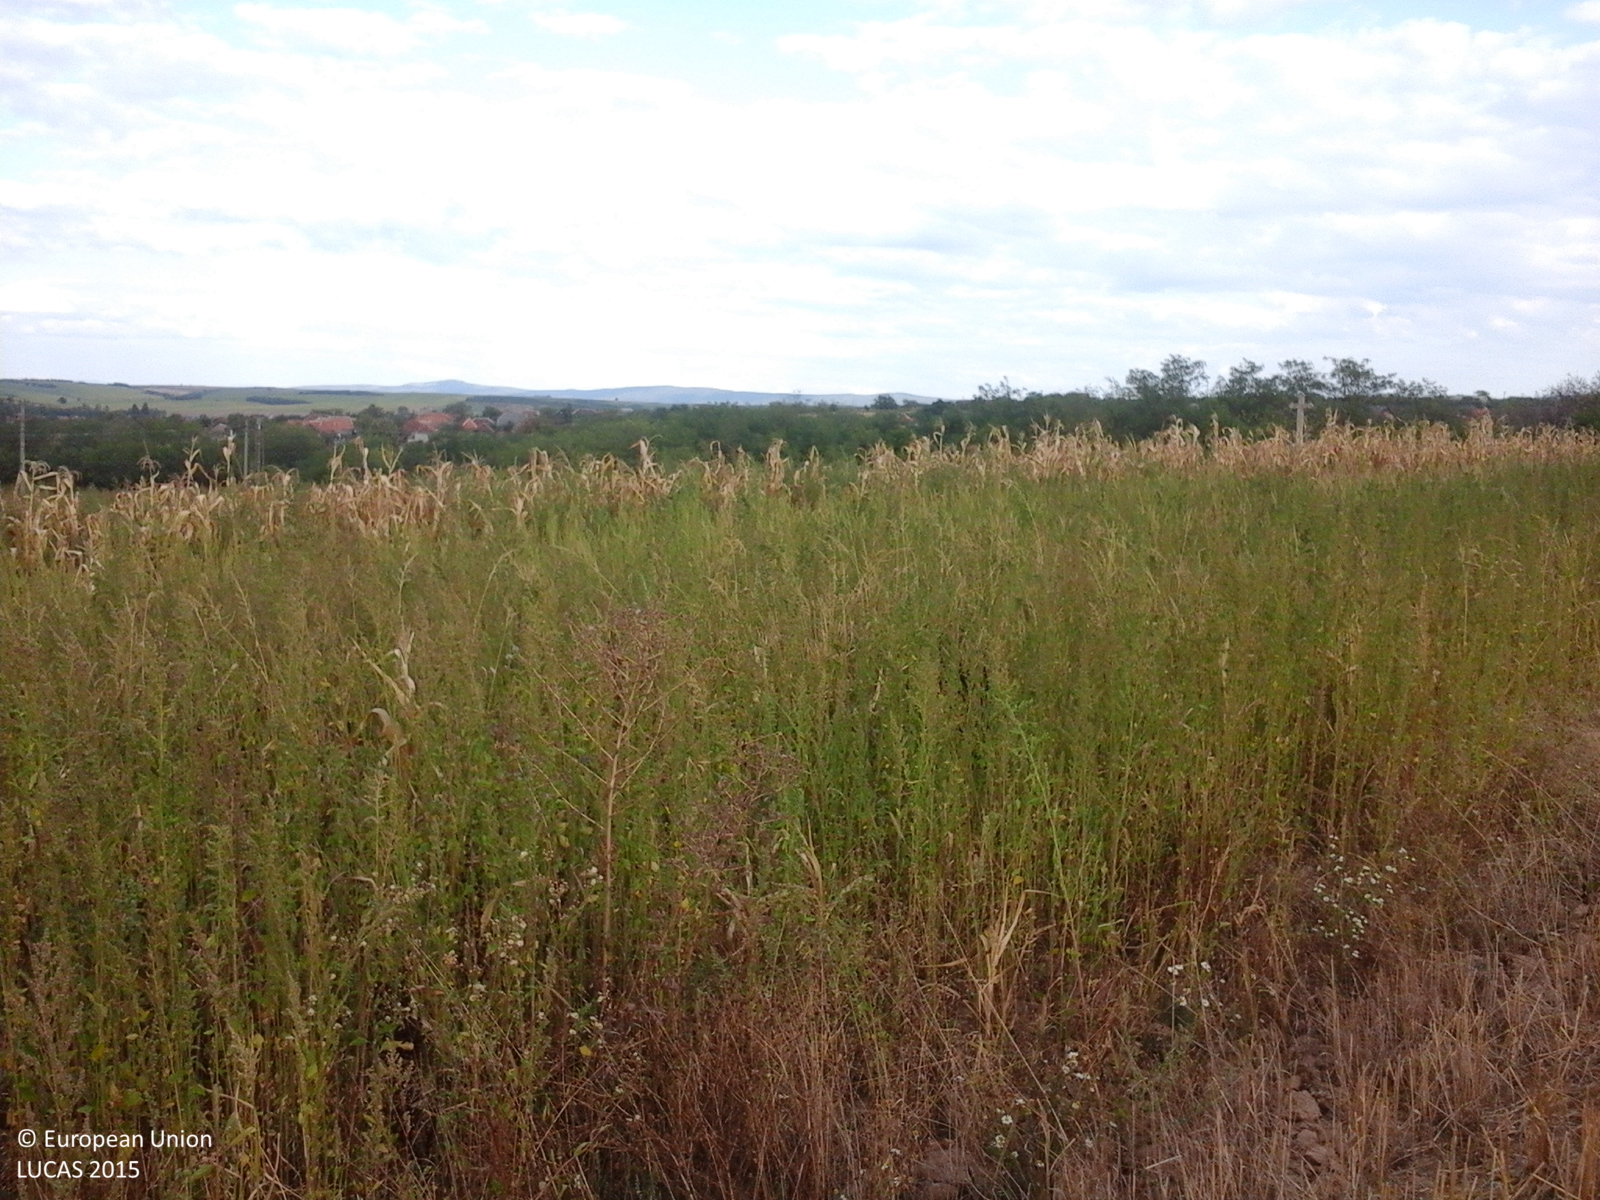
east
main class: Cropland
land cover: Oats
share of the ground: 50 - 75 %
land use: Agriculture (excluding fallow land and kitchen gardens)
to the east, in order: Oats; Spontaneously vegetated surfaces; Maize; Sunflower; Grass margins; Tracks; Grass margins; Tracks; Grass margins; Broadleaved woodland; Ditches and canals; Broadleaved woodland; Grassland without tree/shrub cover; Broadleaved woodland; Electric lines; Broadleaved woodland; Maize
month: September
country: RO
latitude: 47.6043
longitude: 22.9270
